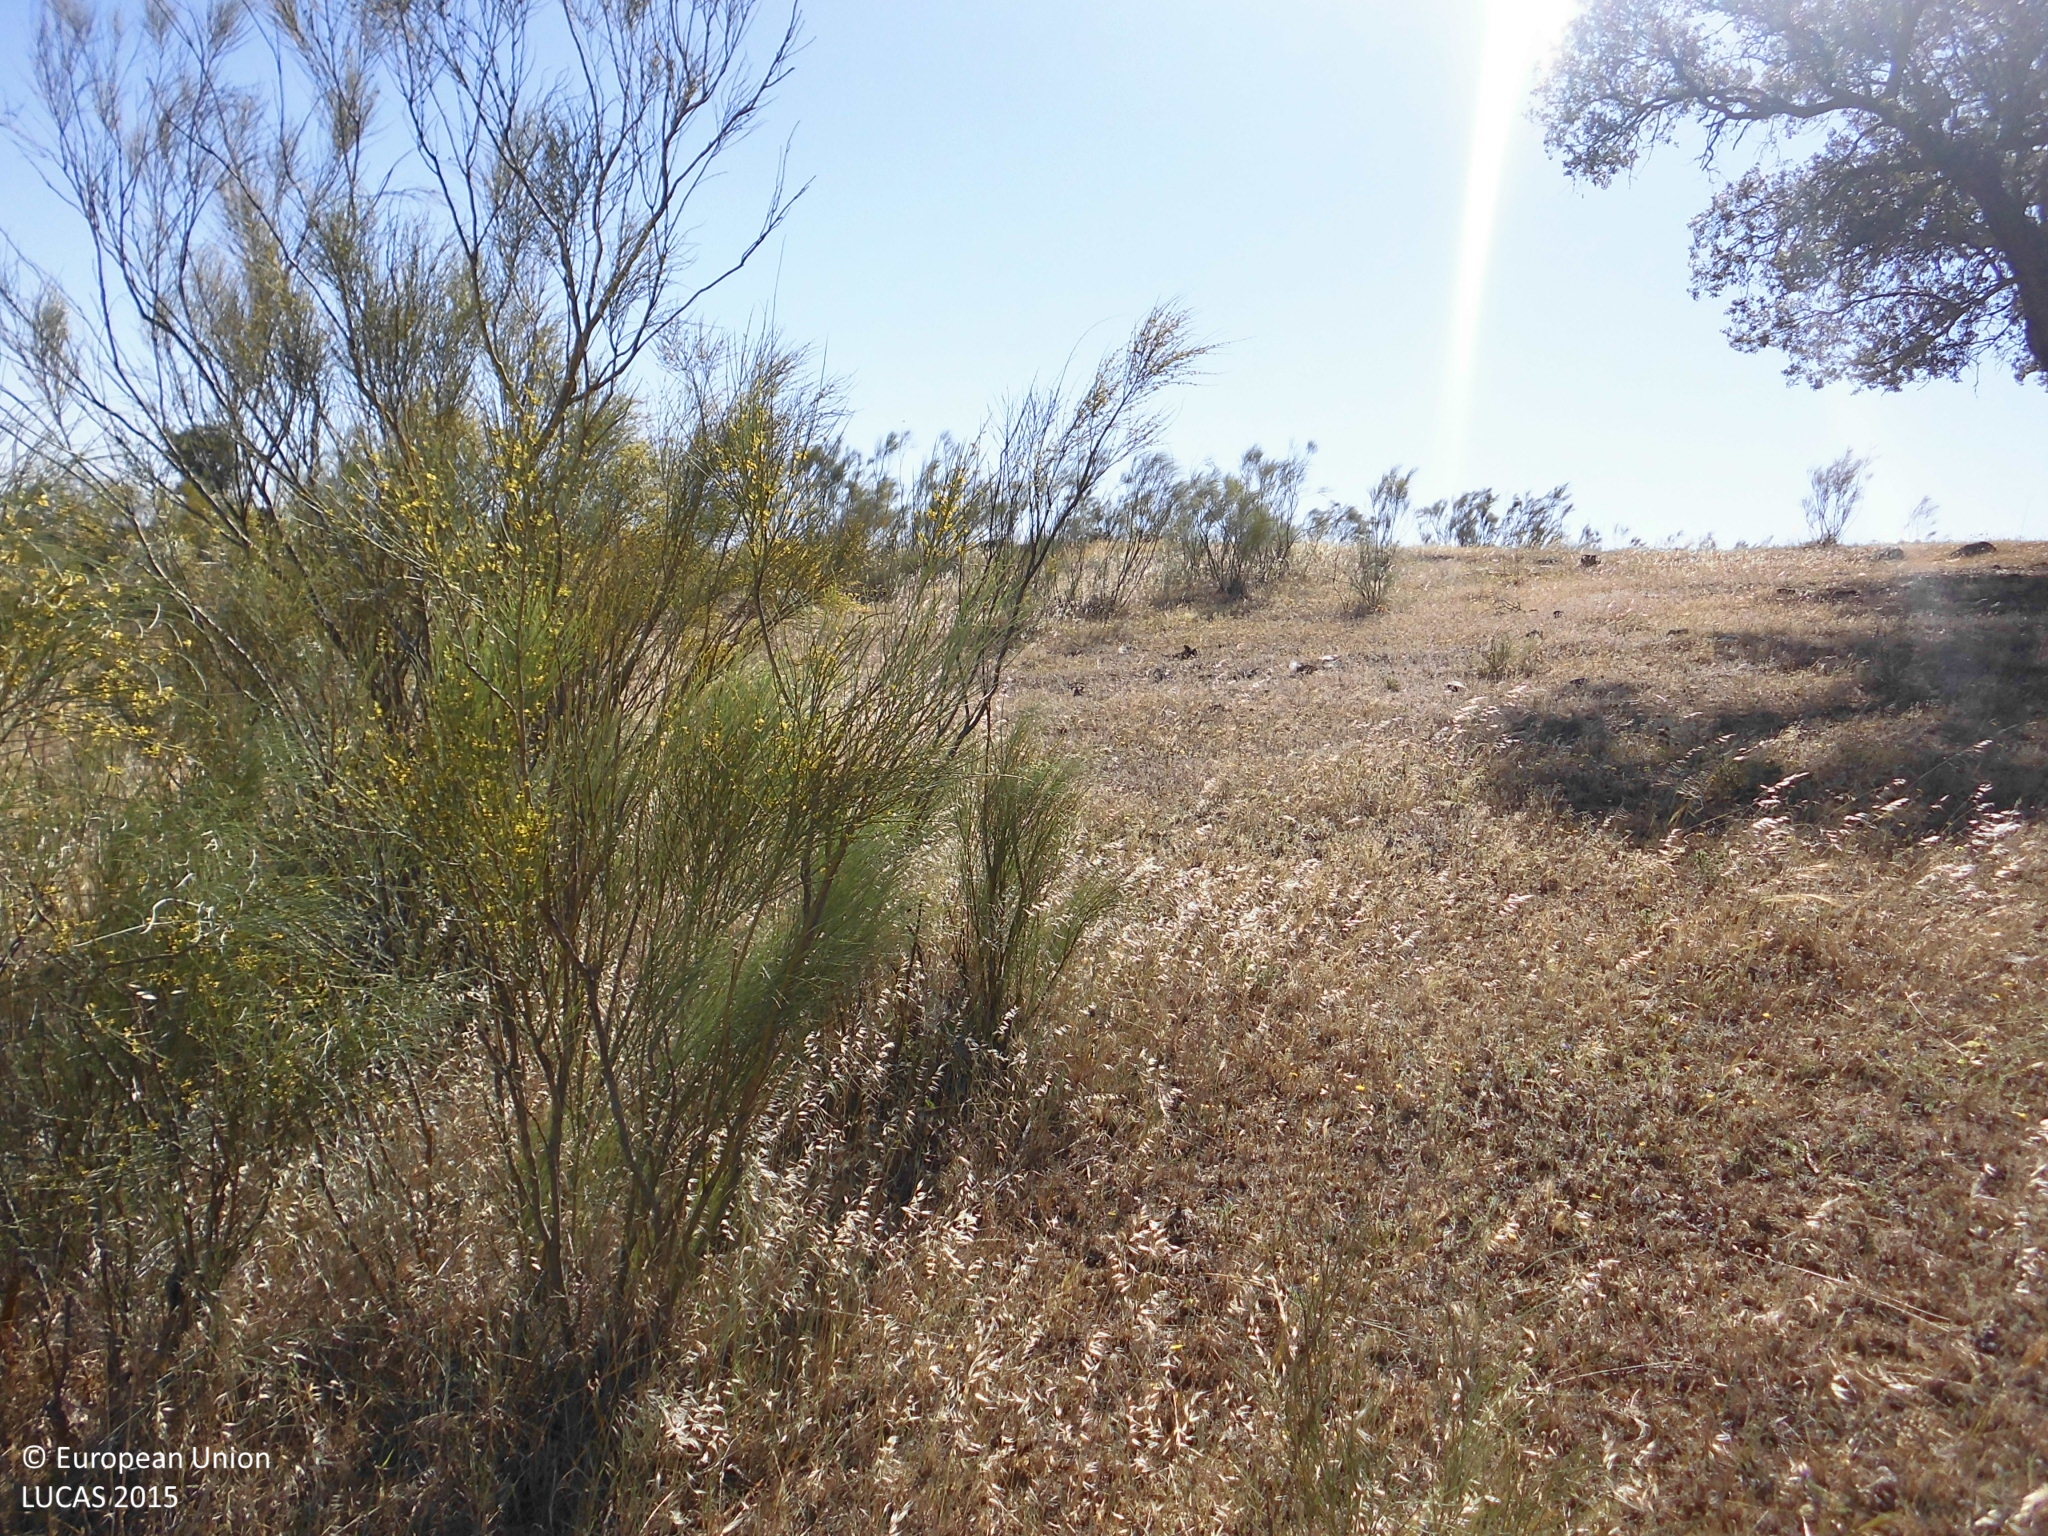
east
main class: Woodland
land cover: Broadleaved woodland
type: broadleaved evergreen forest
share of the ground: 10 - 25 %
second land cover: Grassland without tree/shrub cover
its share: > 75 %
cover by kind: herbaceous plants 65 %, broadleaved forest trees 25 %, shrubs 10 %
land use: Forestry
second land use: Agriculture (excluding fallow land and kitchen gardens)
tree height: > 5 m
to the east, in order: Broadleaved woodland; Grassland without tree/shrub cover; Tracks; Grassland with sparse tree/shrub cover; Fences; Broadleaved woodland
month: May
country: ES
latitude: 39.5164
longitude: -6.9587
